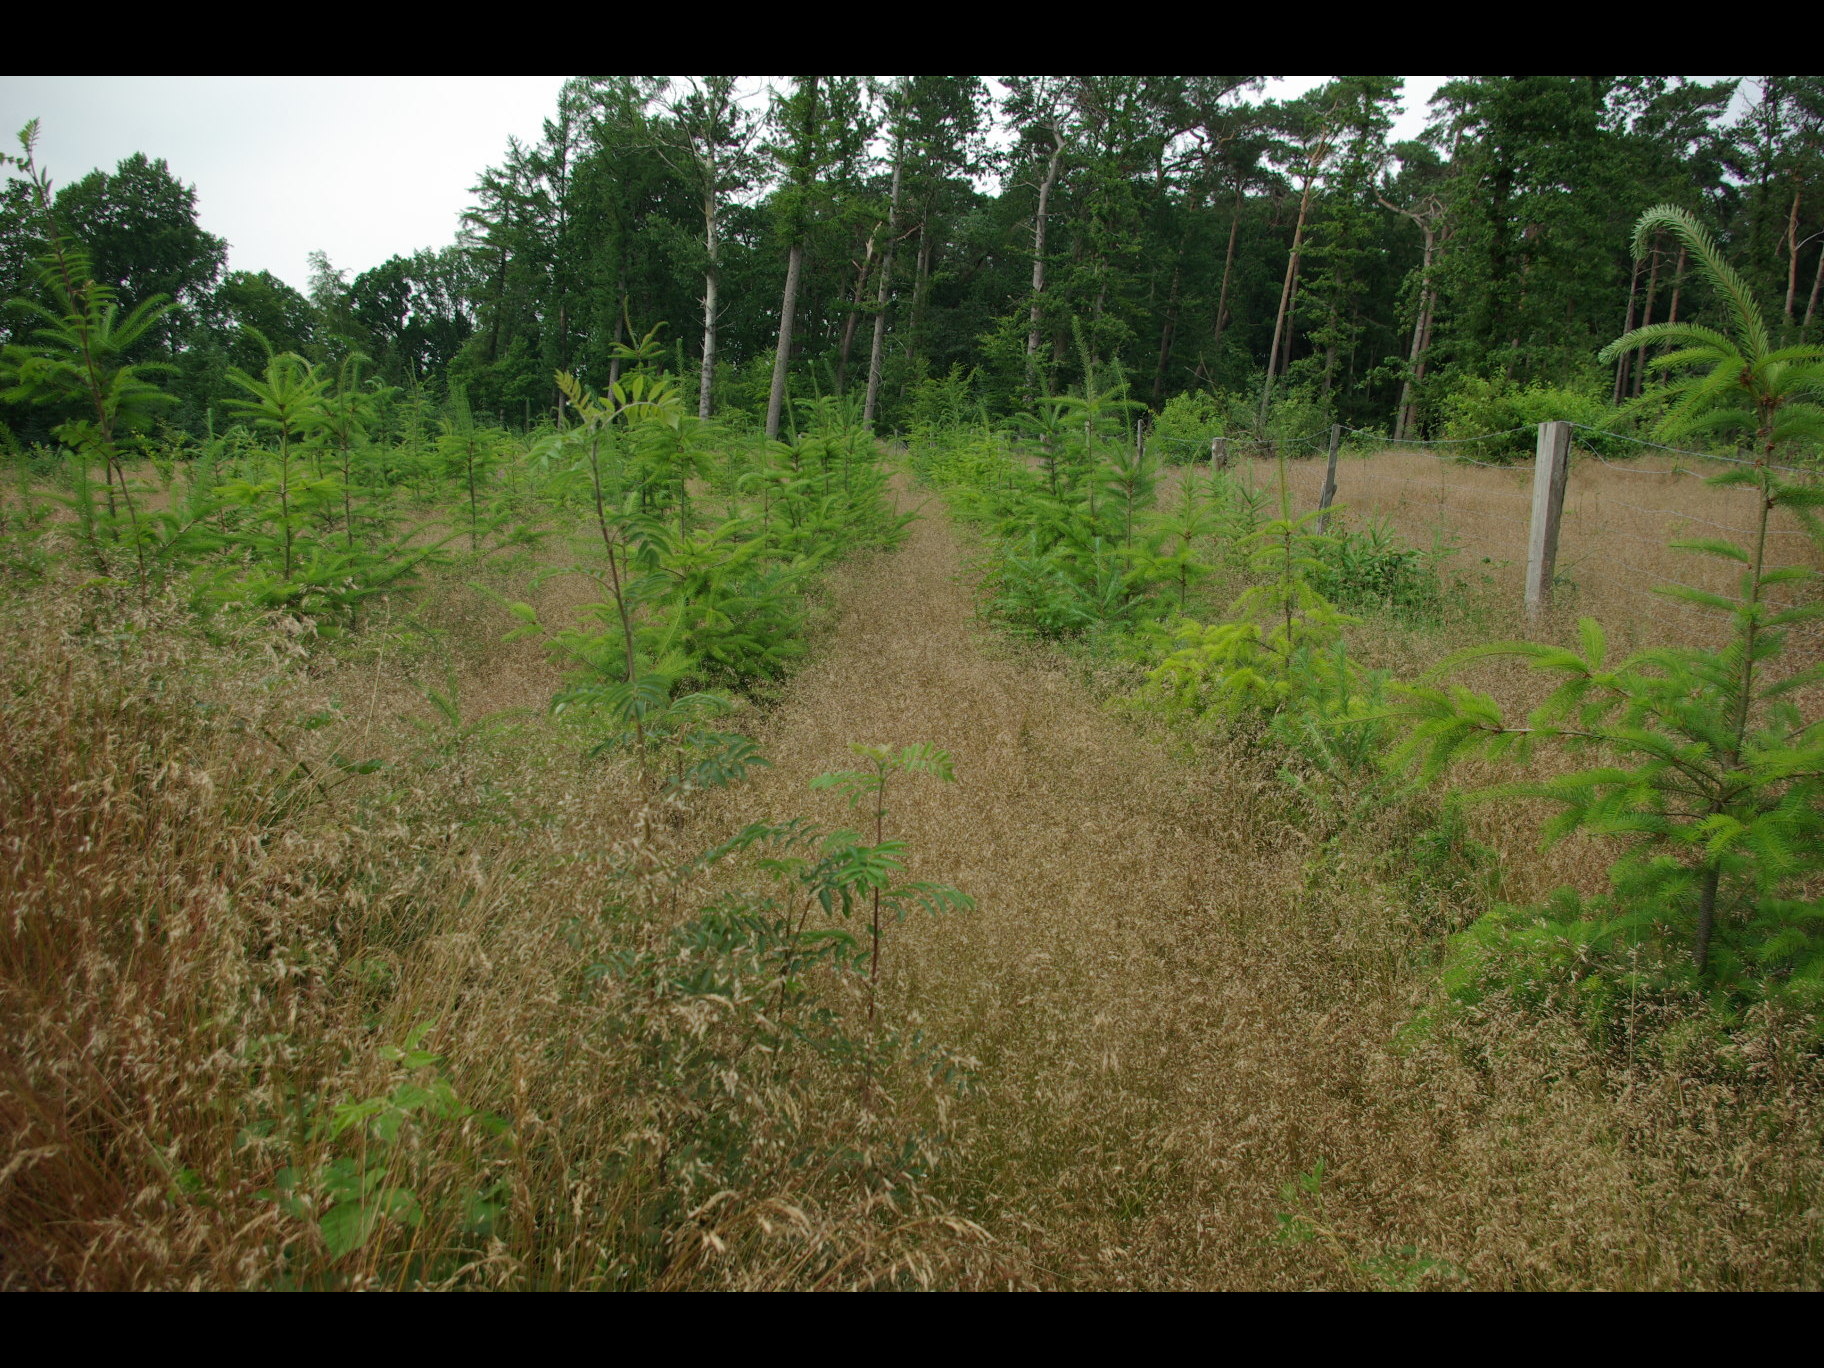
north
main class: Woodland
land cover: Other coniferous woodland
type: hemiboreal forest and nemoral coniferous forest and mixed broadleaved-coniferous forest
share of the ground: 50 - 75 %
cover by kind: coniferous forest trees 50 %, herbaceous plants 40 %, broadleaved forest trees 5 %, shrubs 5 %
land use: Forestry
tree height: < 5 m
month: July
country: DE
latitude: 54.1922
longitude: 9.6477
